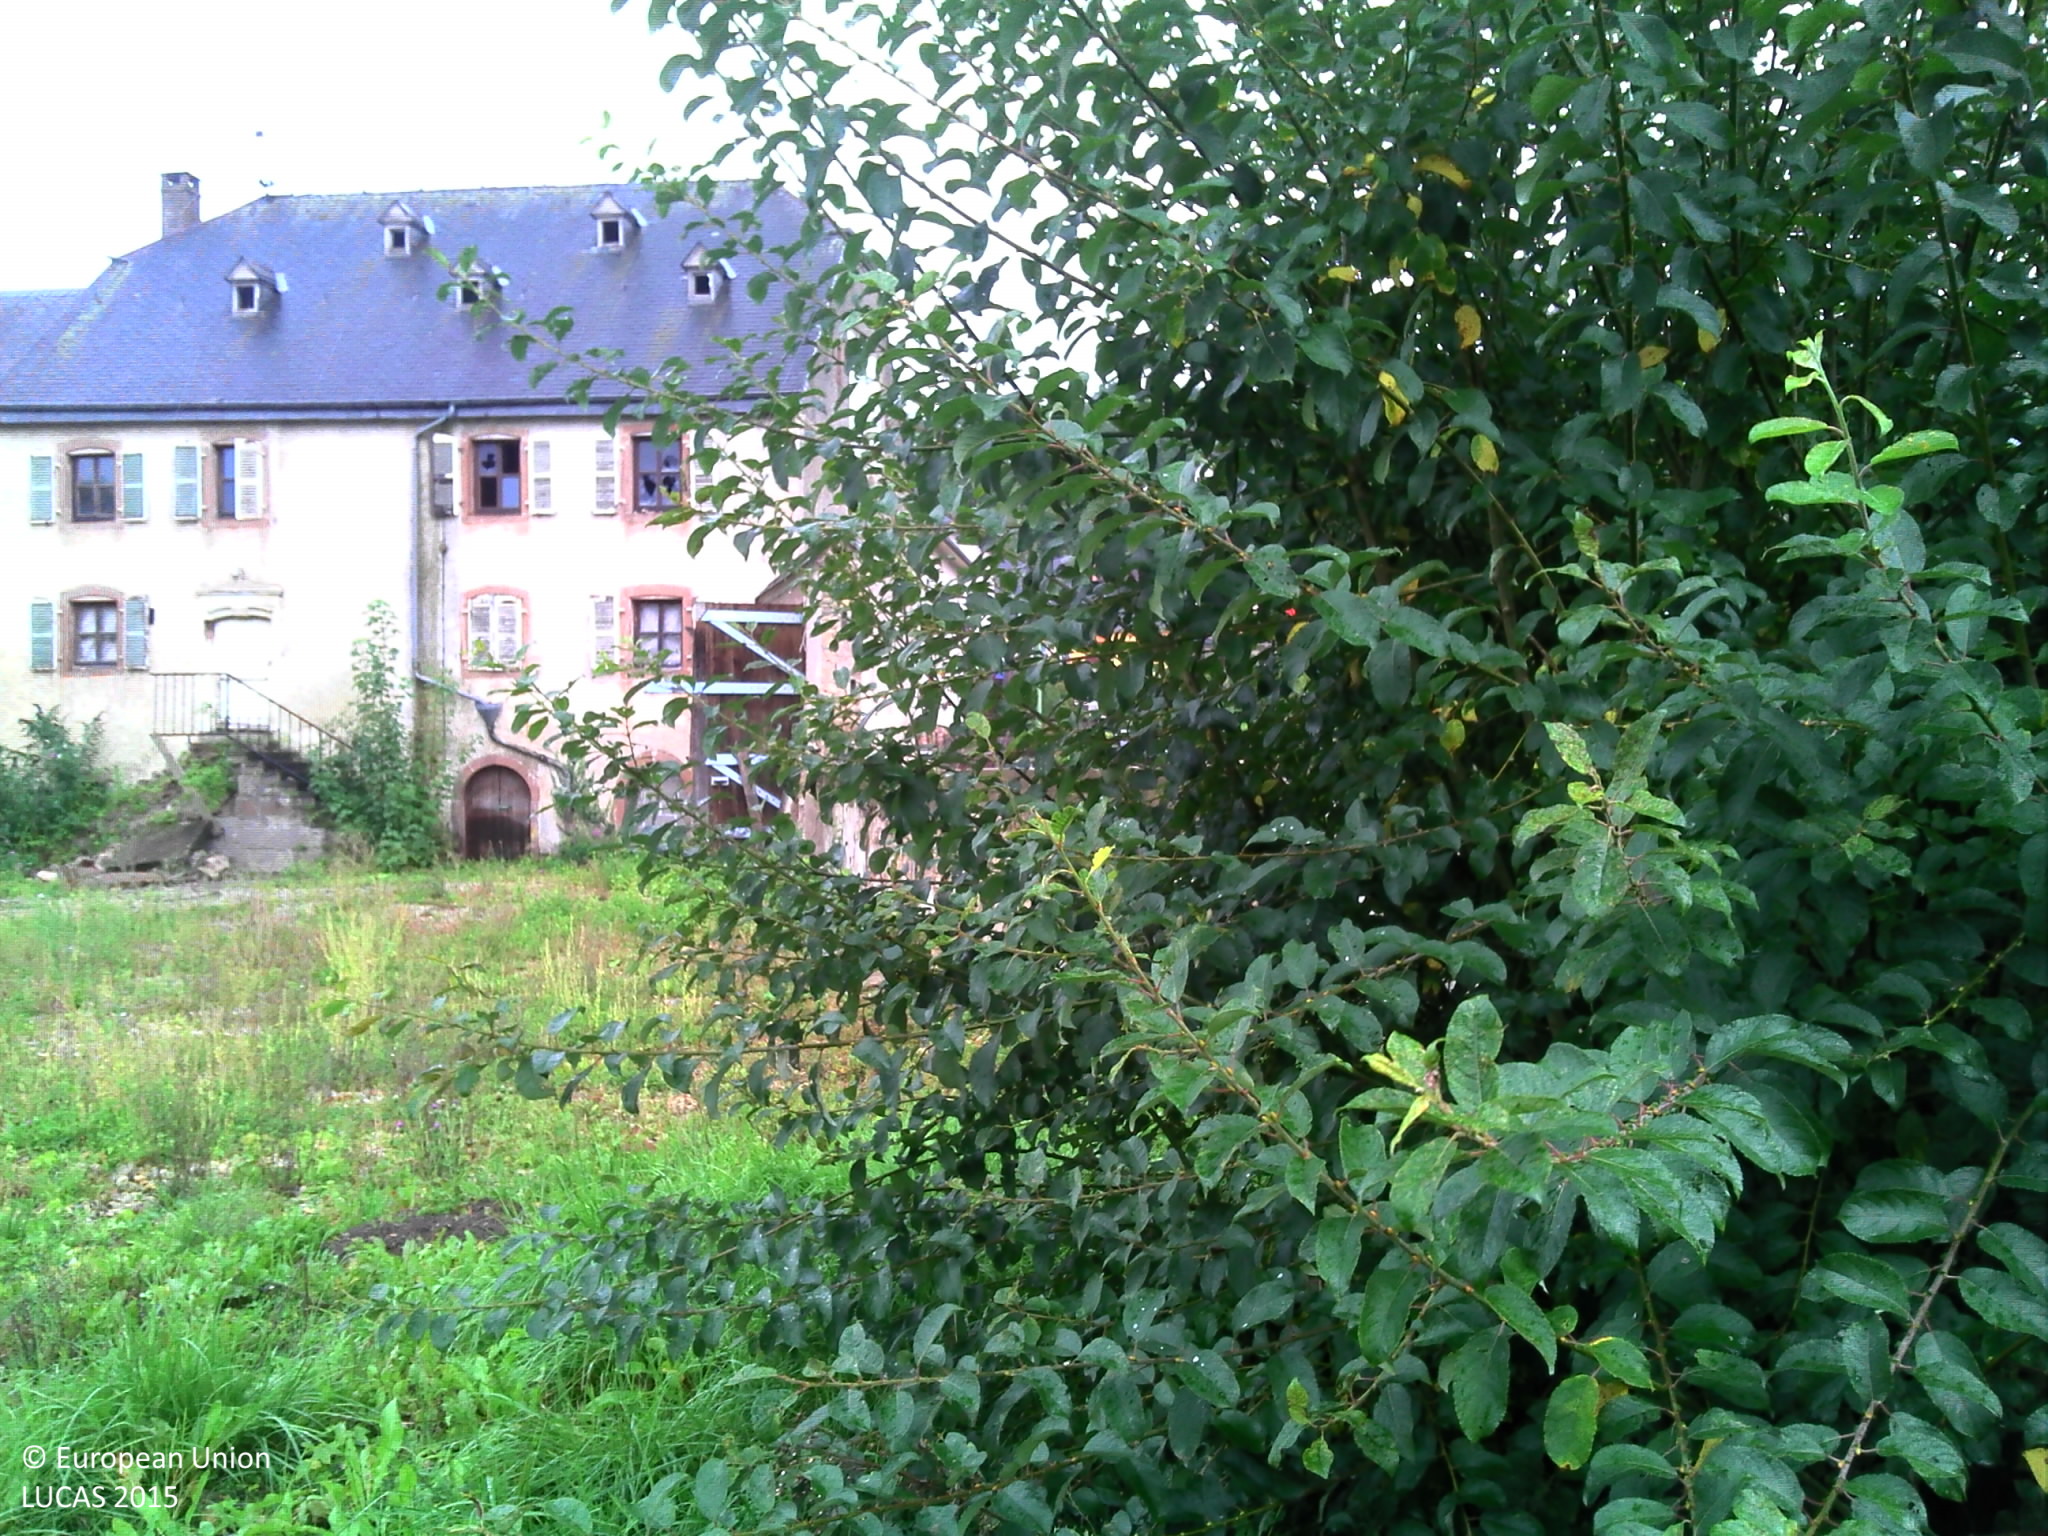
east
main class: Grassland
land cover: Spontaneously vegetated surfaces
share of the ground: > 75 %
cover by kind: herbaceous plants 90 %, unconsolidated bare surface 10 %
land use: Abandoned areas
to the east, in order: Spontaneously vegetated surfaces; Single bushes/trees; Spontaneously vegetated surfaces; Artificial constructions in urban areas
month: September
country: LU
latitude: 49.8113
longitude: 6.0944
